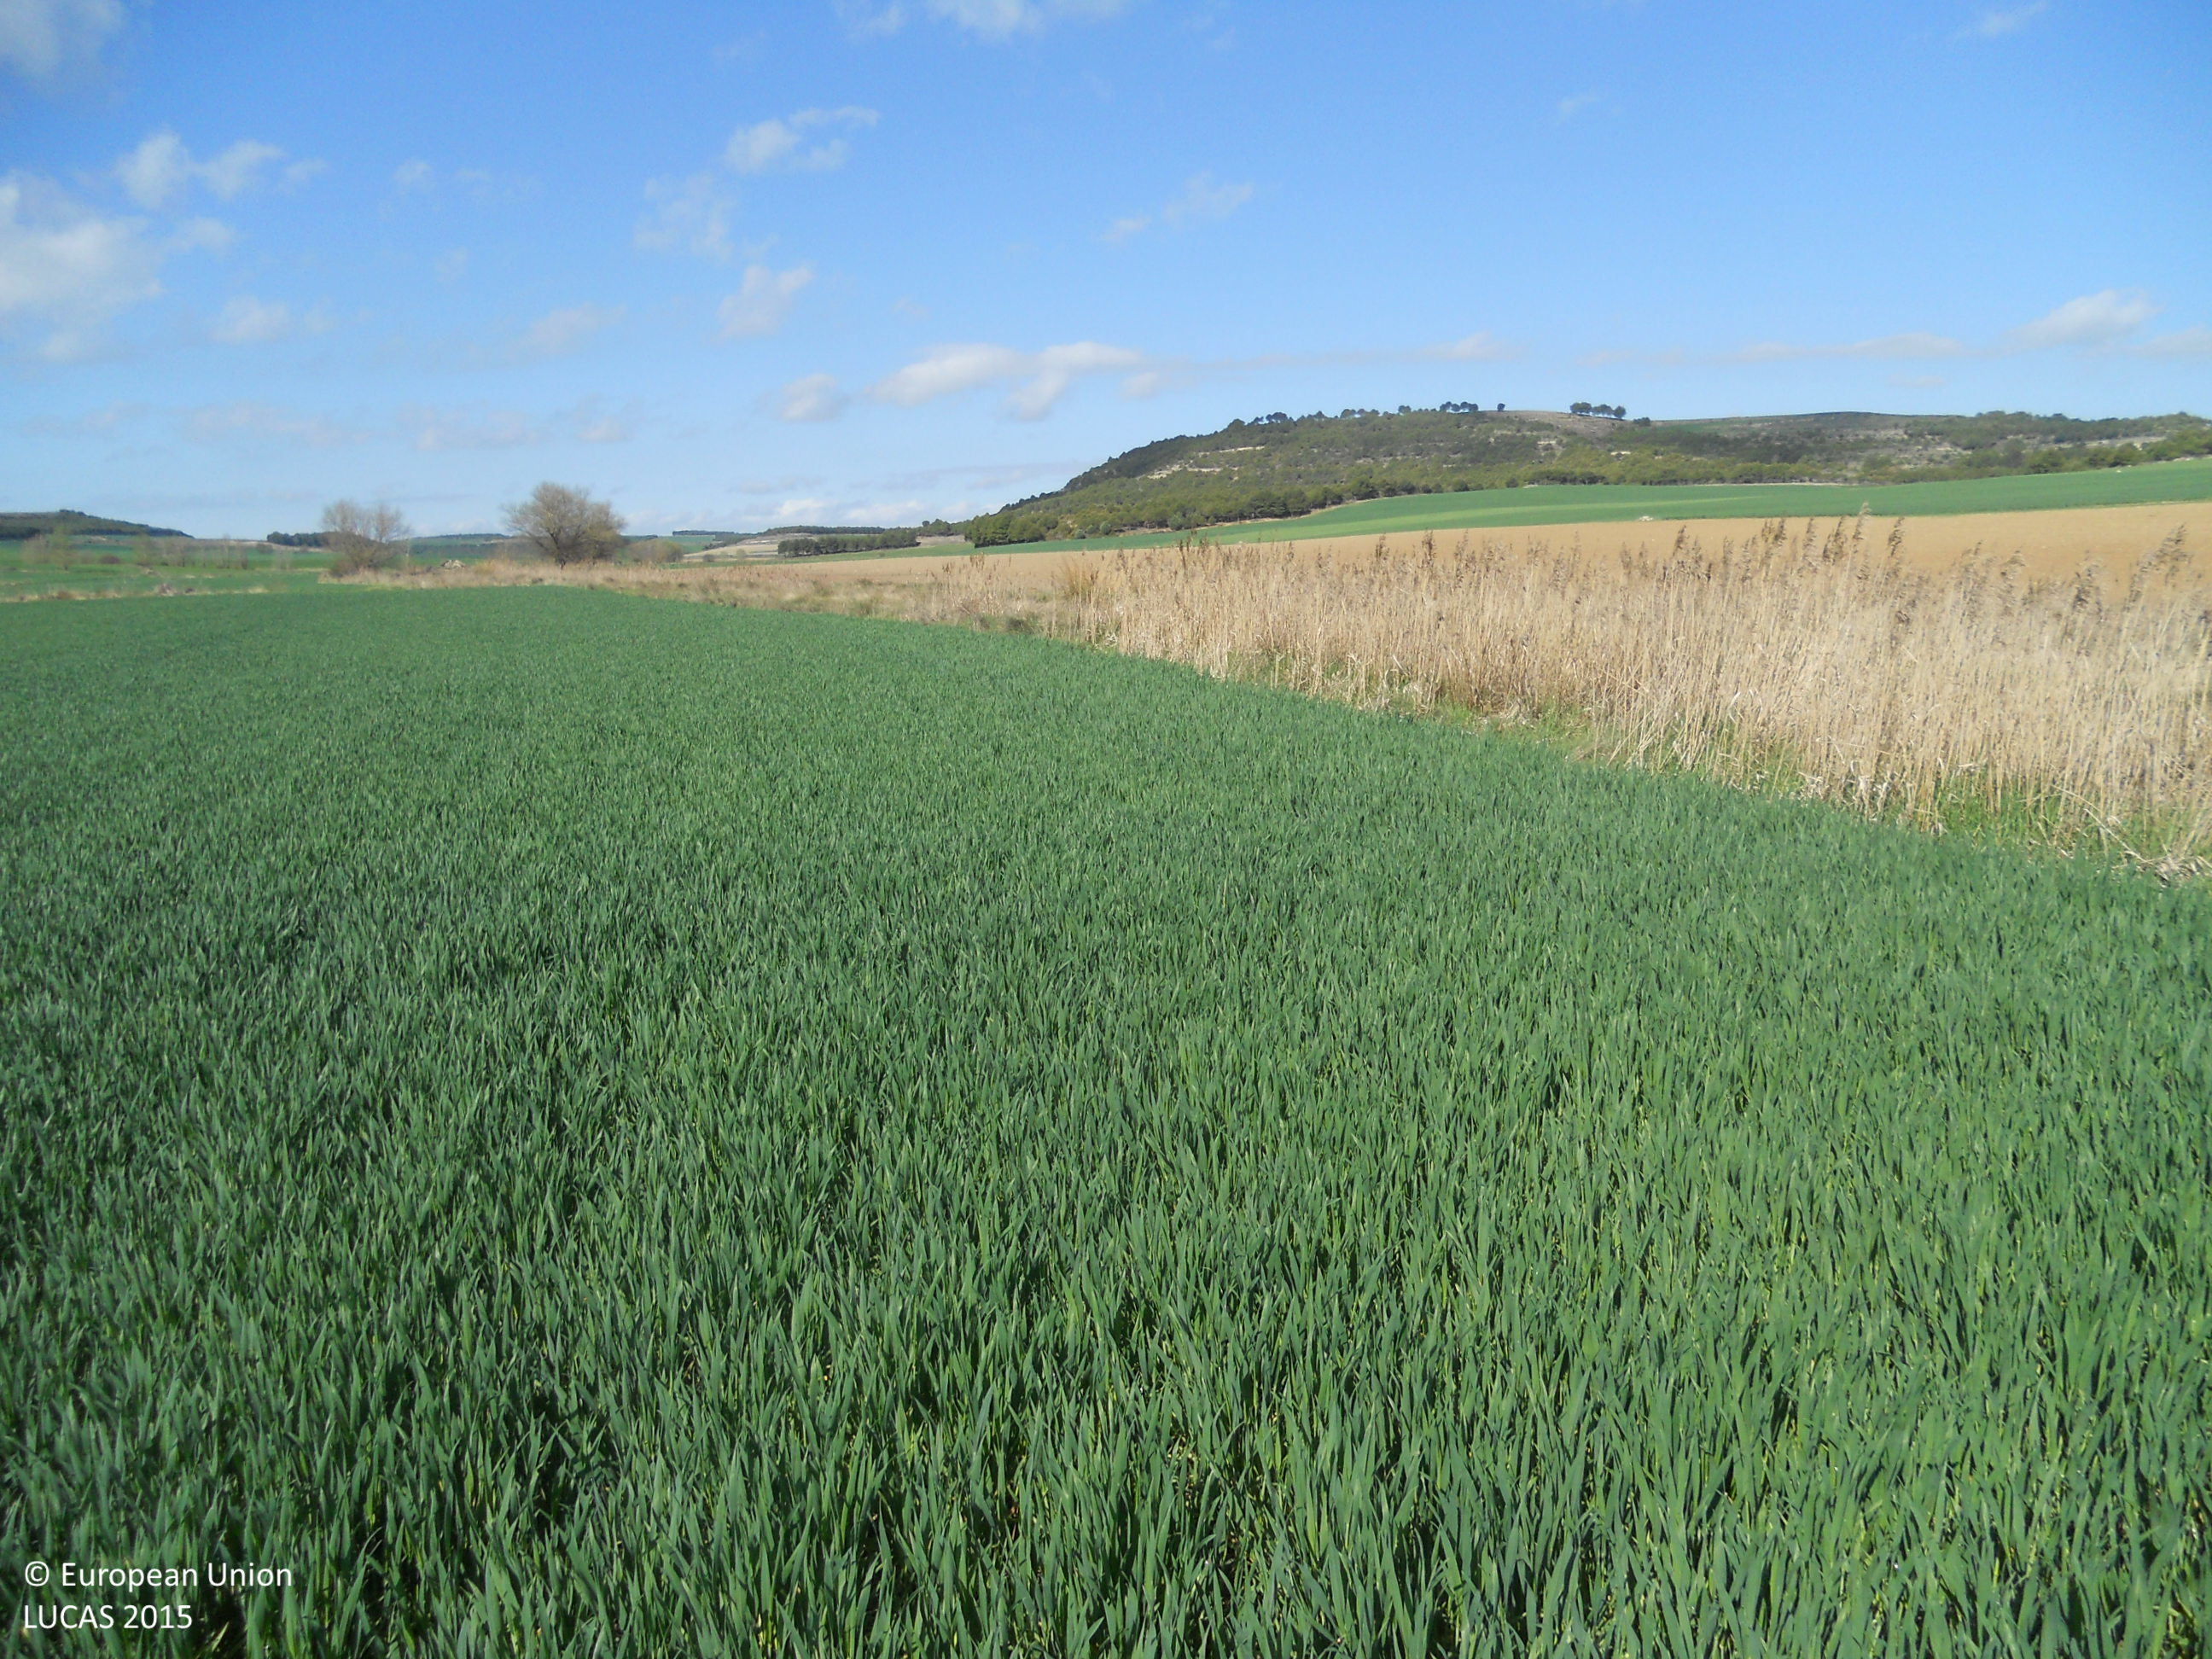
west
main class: Cropland
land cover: Common wheat
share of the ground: > 75 %
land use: Agriculture (excluding fallow land and kitchen gardens)
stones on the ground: < 10 %
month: April
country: ES
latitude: 42.1978
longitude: -4.3228
